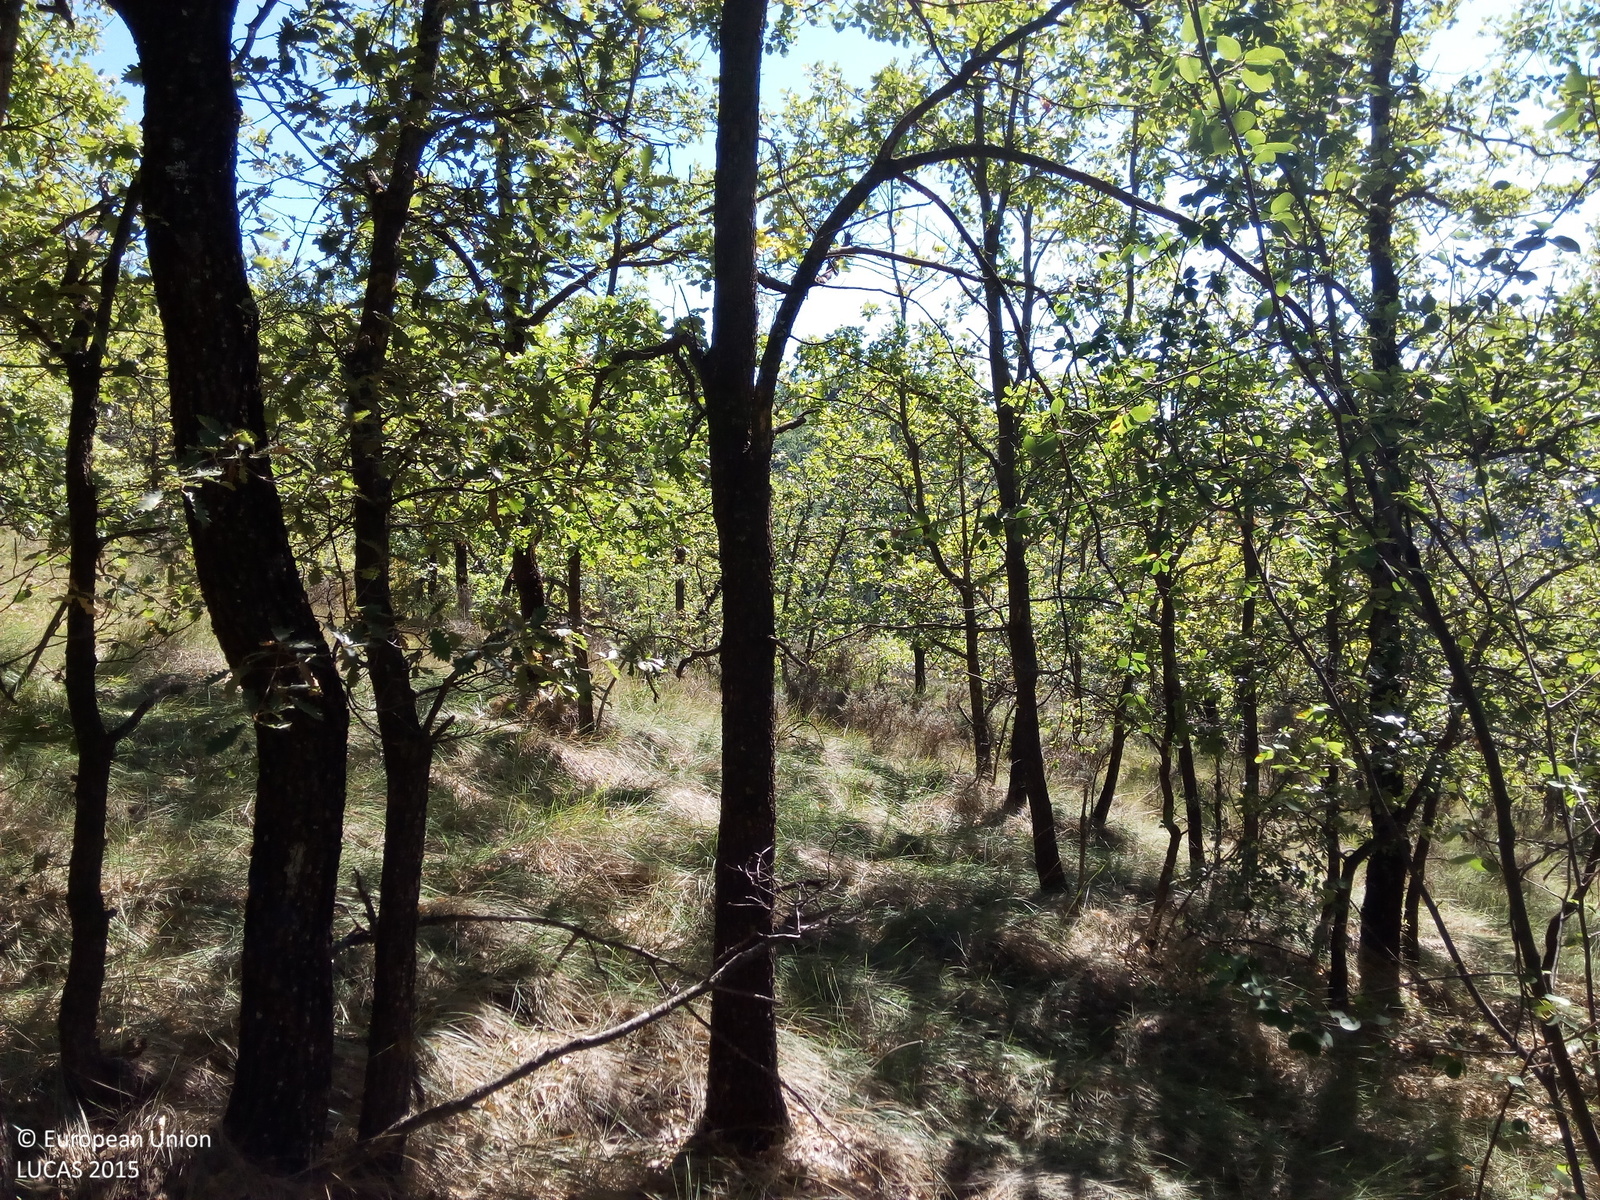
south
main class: Woodland
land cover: Broadleaved woodland
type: broadleaved evergreen forest
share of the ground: > 75 %
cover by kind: broadleaved forest trees 100 %
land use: Semi-natural and natural areas not in use
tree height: > 5 m
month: September
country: ES
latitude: 42.3409
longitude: 0.5751
